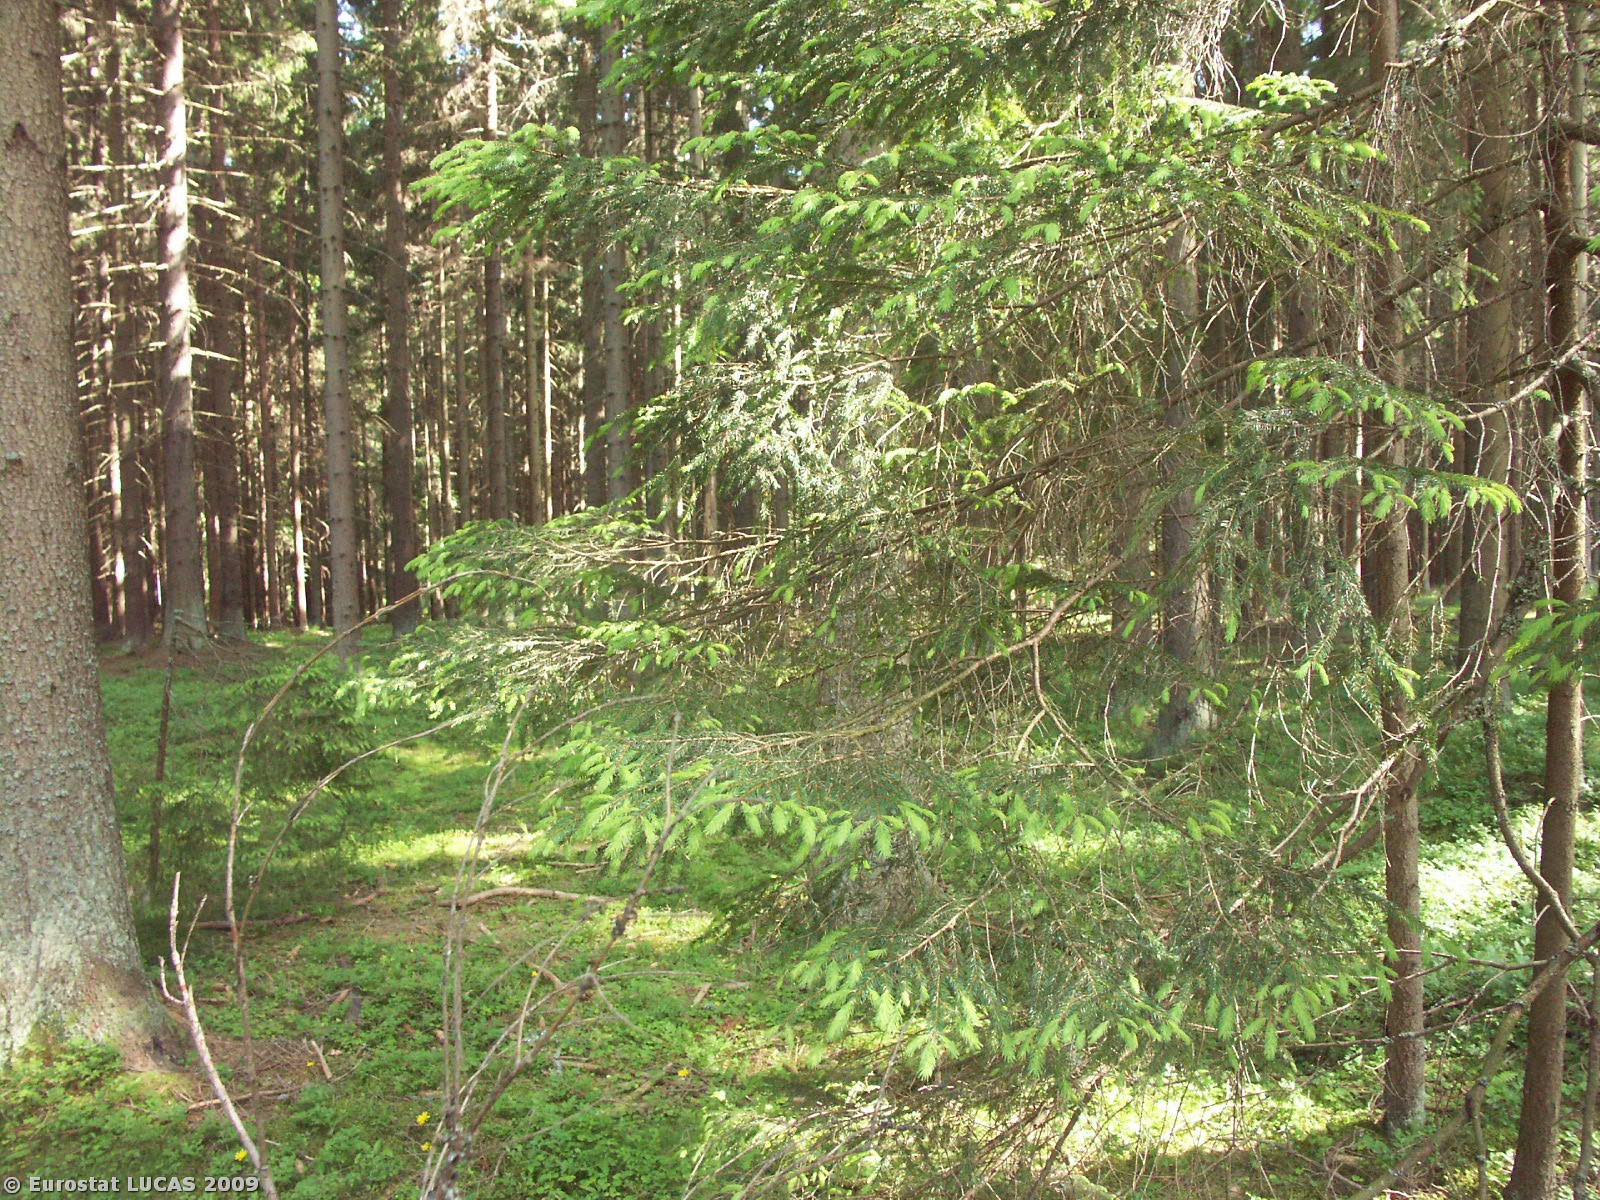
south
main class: Woodland
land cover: Coniferous woodland
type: hemiboreal forest and nemoral coniferous forest and mixed broadleaved-coniferous forest
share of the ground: > 75 %
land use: Forestry
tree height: > 5 m
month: June
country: CZ
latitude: 48.7221
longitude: 14.1463
